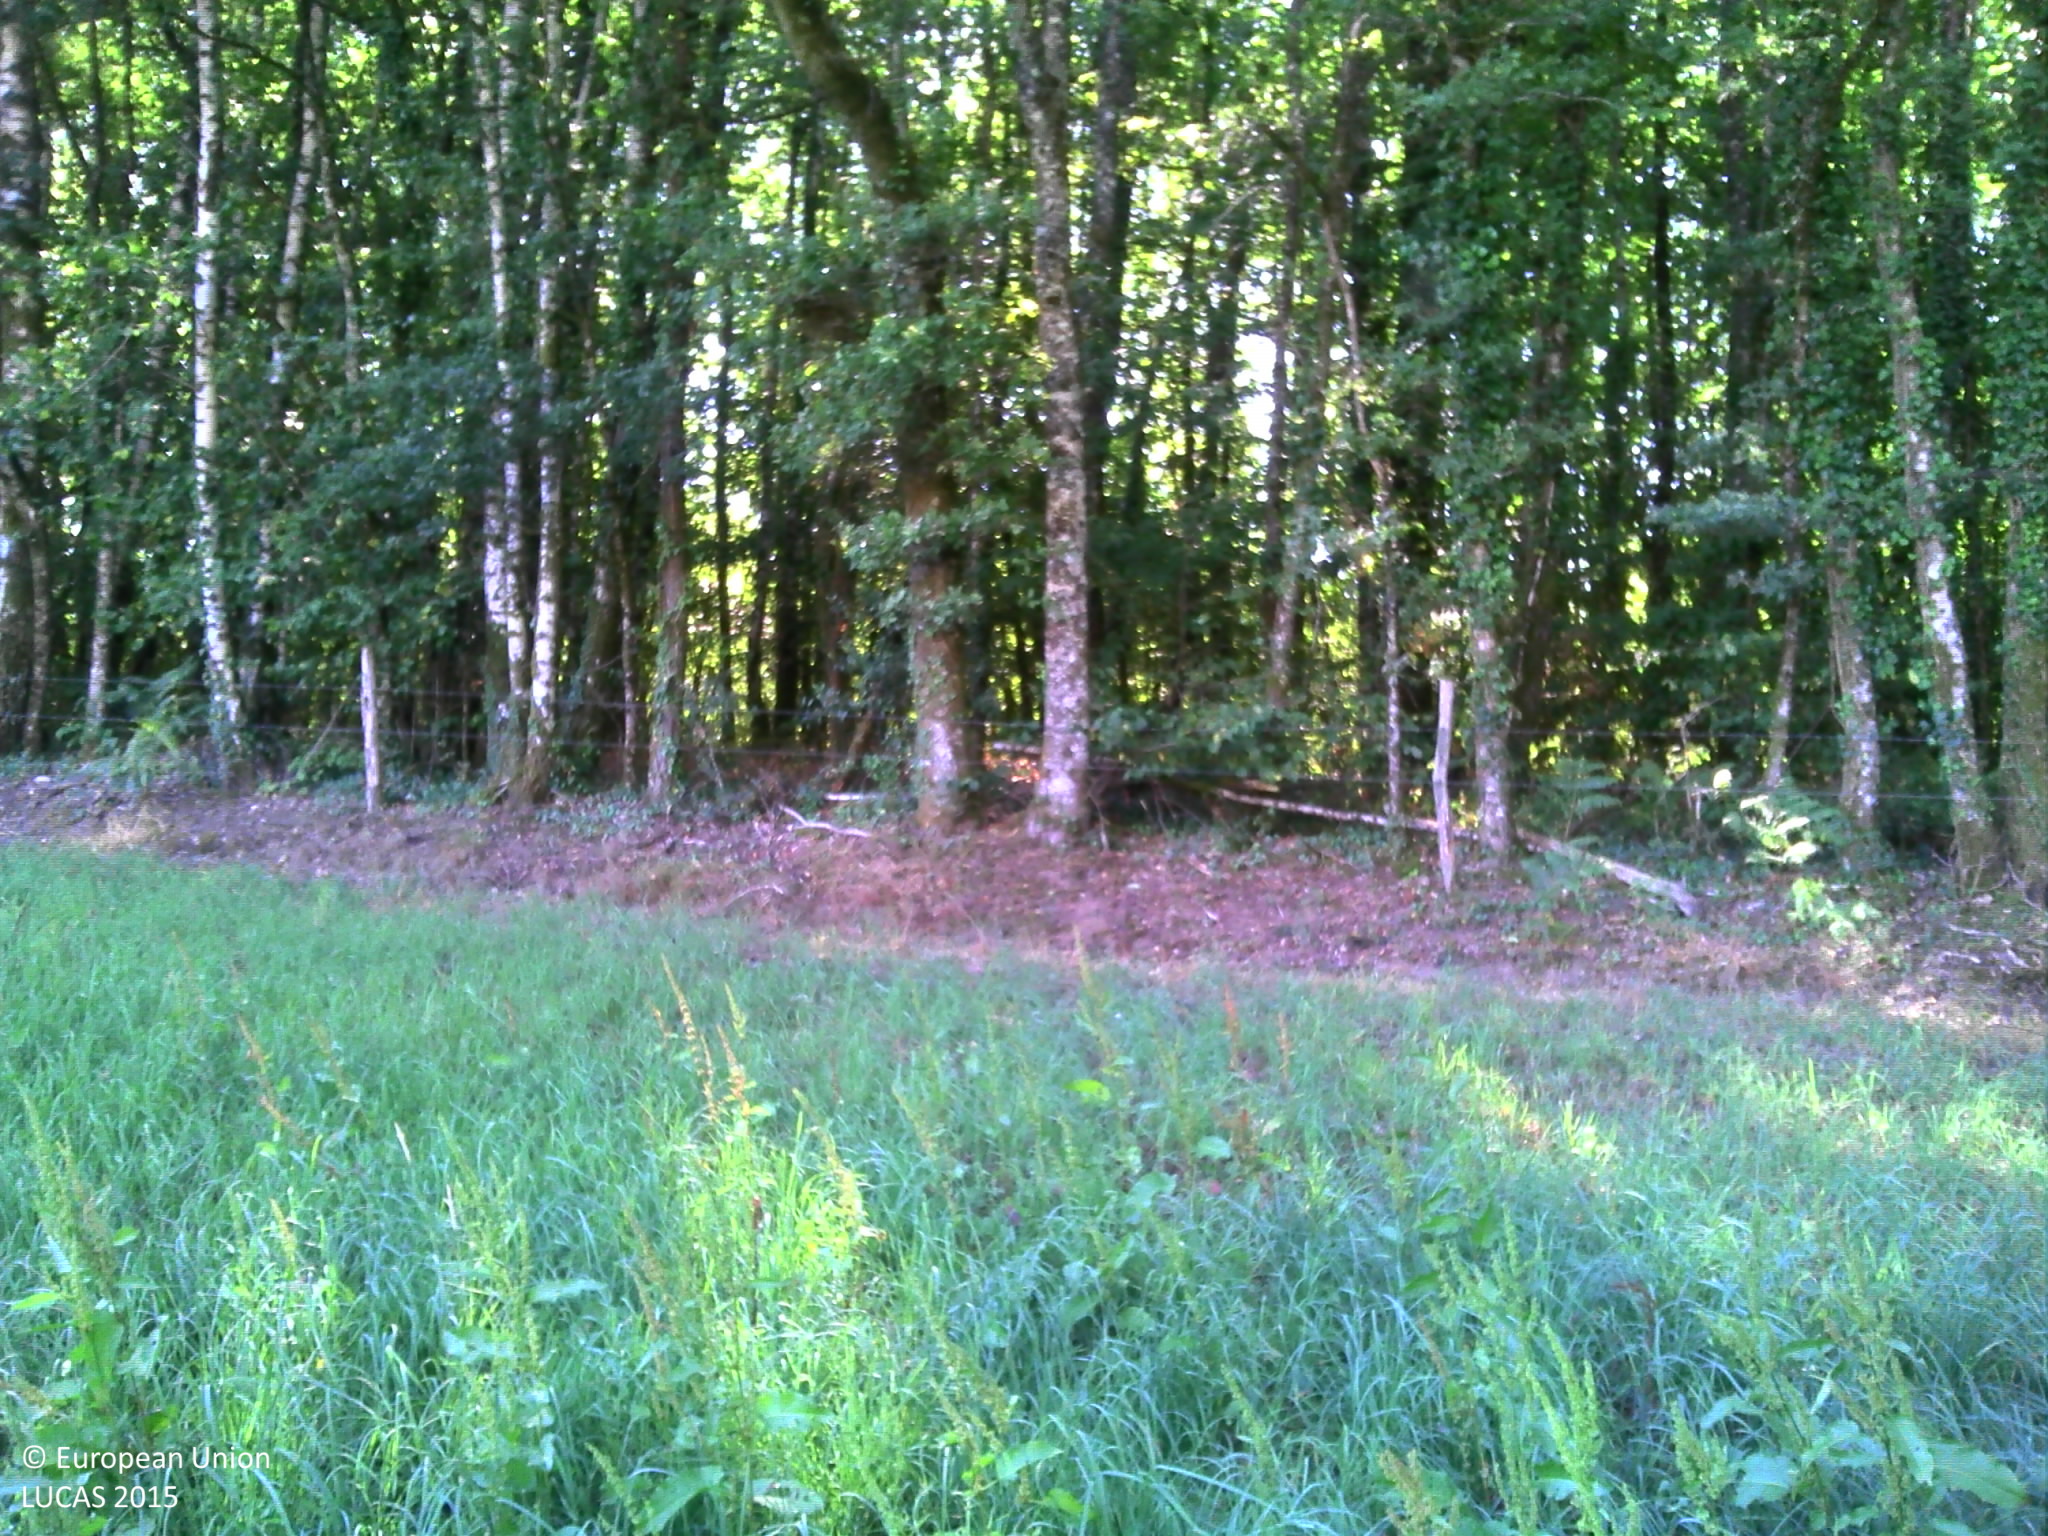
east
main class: Grassland
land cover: Grassland without tree/shrub cover
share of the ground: > 75 %
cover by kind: herbaceous plants 100 %
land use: Agriculture (excluding fallow land and kitchen gardens)
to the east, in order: Grassland without tree/shrub cover; Fences; Broadleaved woodland; Fences; Grassland without tree/shrub cover; Abandoned hedges; Fences; Tracks; Grassland without tree/shrub cover; Tracks; Broadleaved woodland; Tracks; Pine dominated coniferous woodland; Broadleaved woodland; Ditches and canals; Broadleaved woodland; Ditches and canals; Broadleaved woodland; Rivers and streams; Abandoned hedges; Broadleaved woodland; Grassland without tree/shrub cover
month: July
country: FR
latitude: 45.5360
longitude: 1.6578
